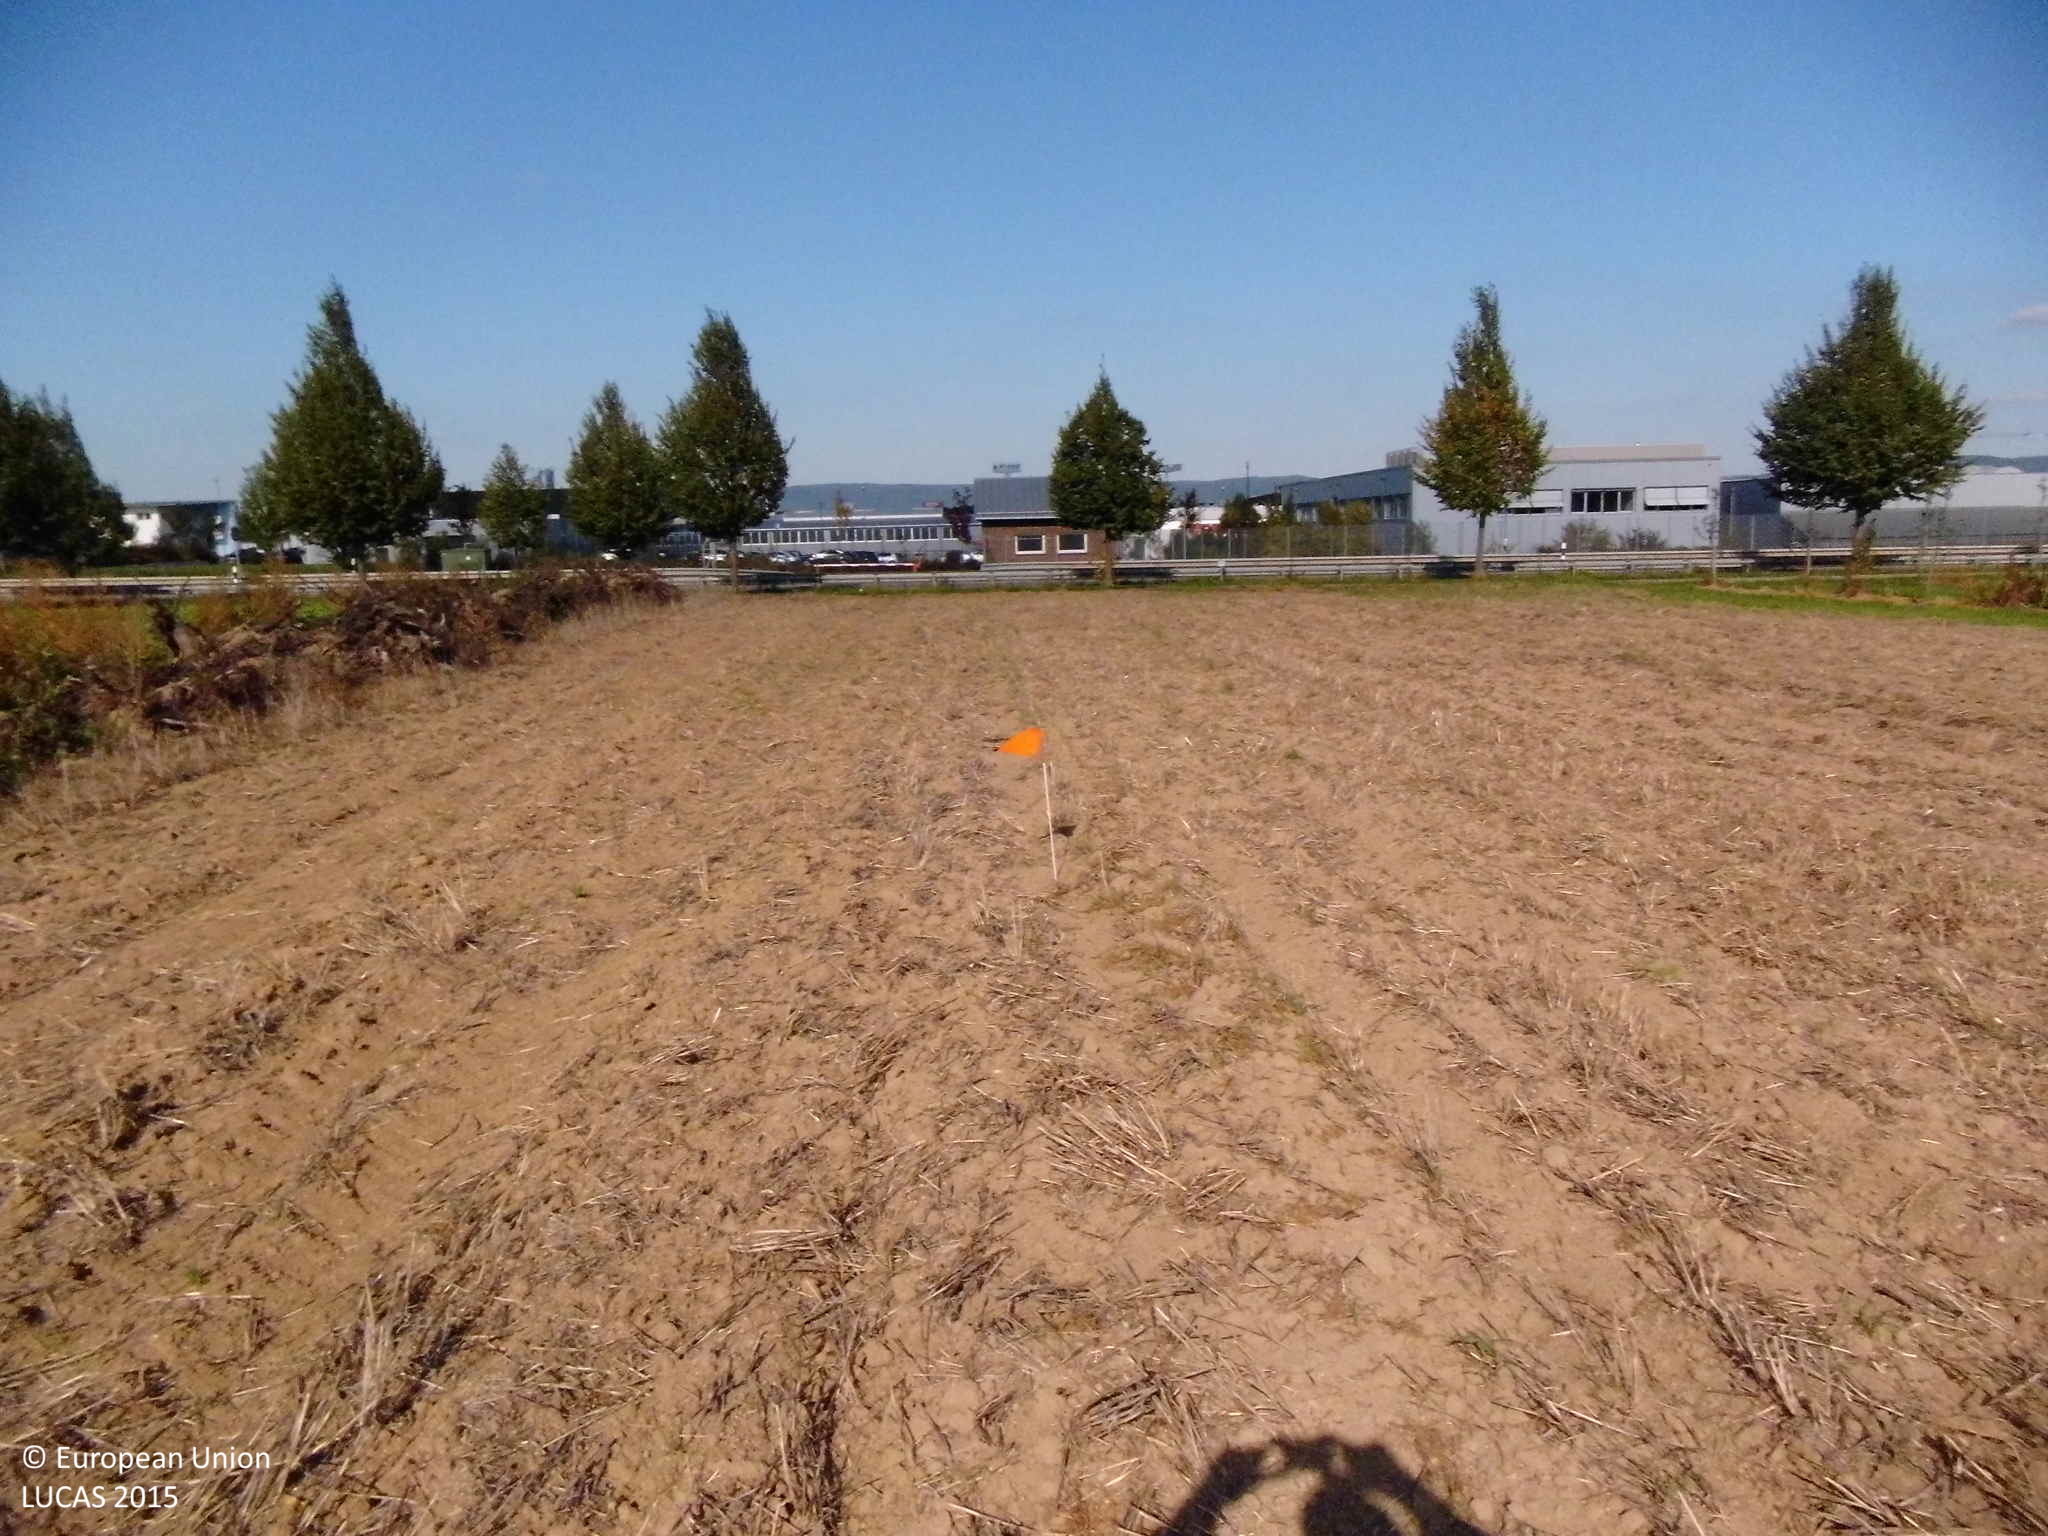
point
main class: Artificial land
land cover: Other artificial areas
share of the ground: < 10 %
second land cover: Common wheat
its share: < 10 %
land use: Electricity, gas and thermal power distribution
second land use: Agriculture (excluding fallow land and kitchen gardens)
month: September
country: DE
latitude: 50.3910
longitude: 7.5106
